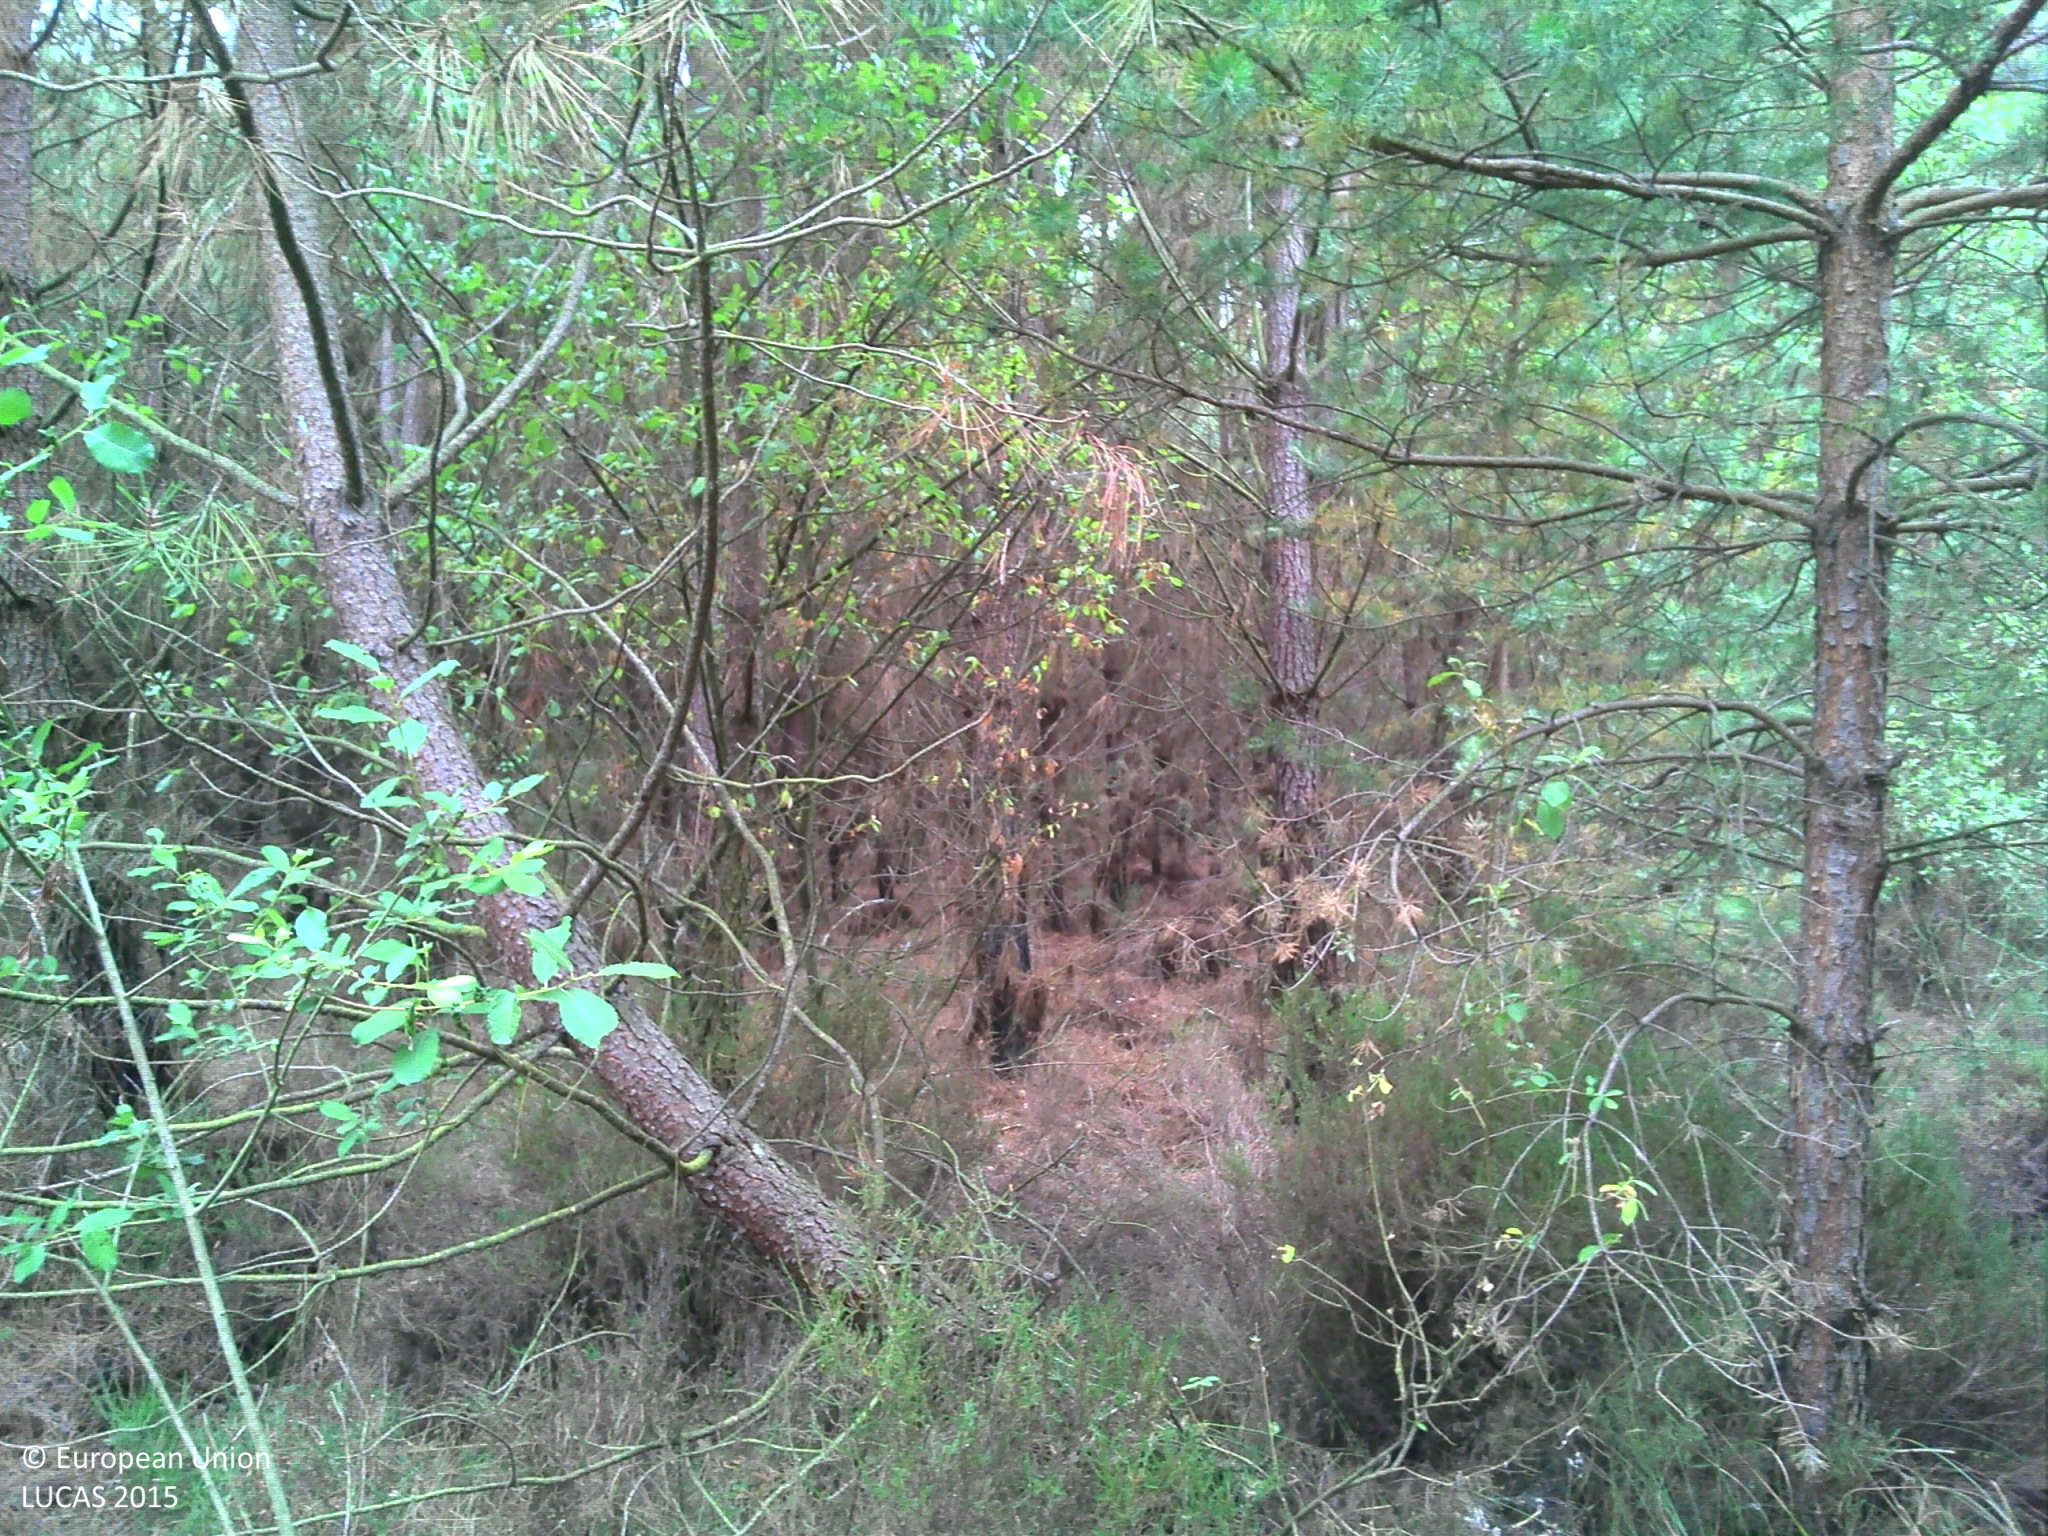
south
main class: Woodland
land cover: Pine dominated coniferous woodland
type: exotic forest
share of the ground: > 75 %
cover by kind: coniferous forest trees 70 %, shrubs 15 %, herbaceous plants 15 %
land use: Forestry
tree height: > 5 m
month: July
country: FR
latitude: 47.9240
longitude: 0.3263
